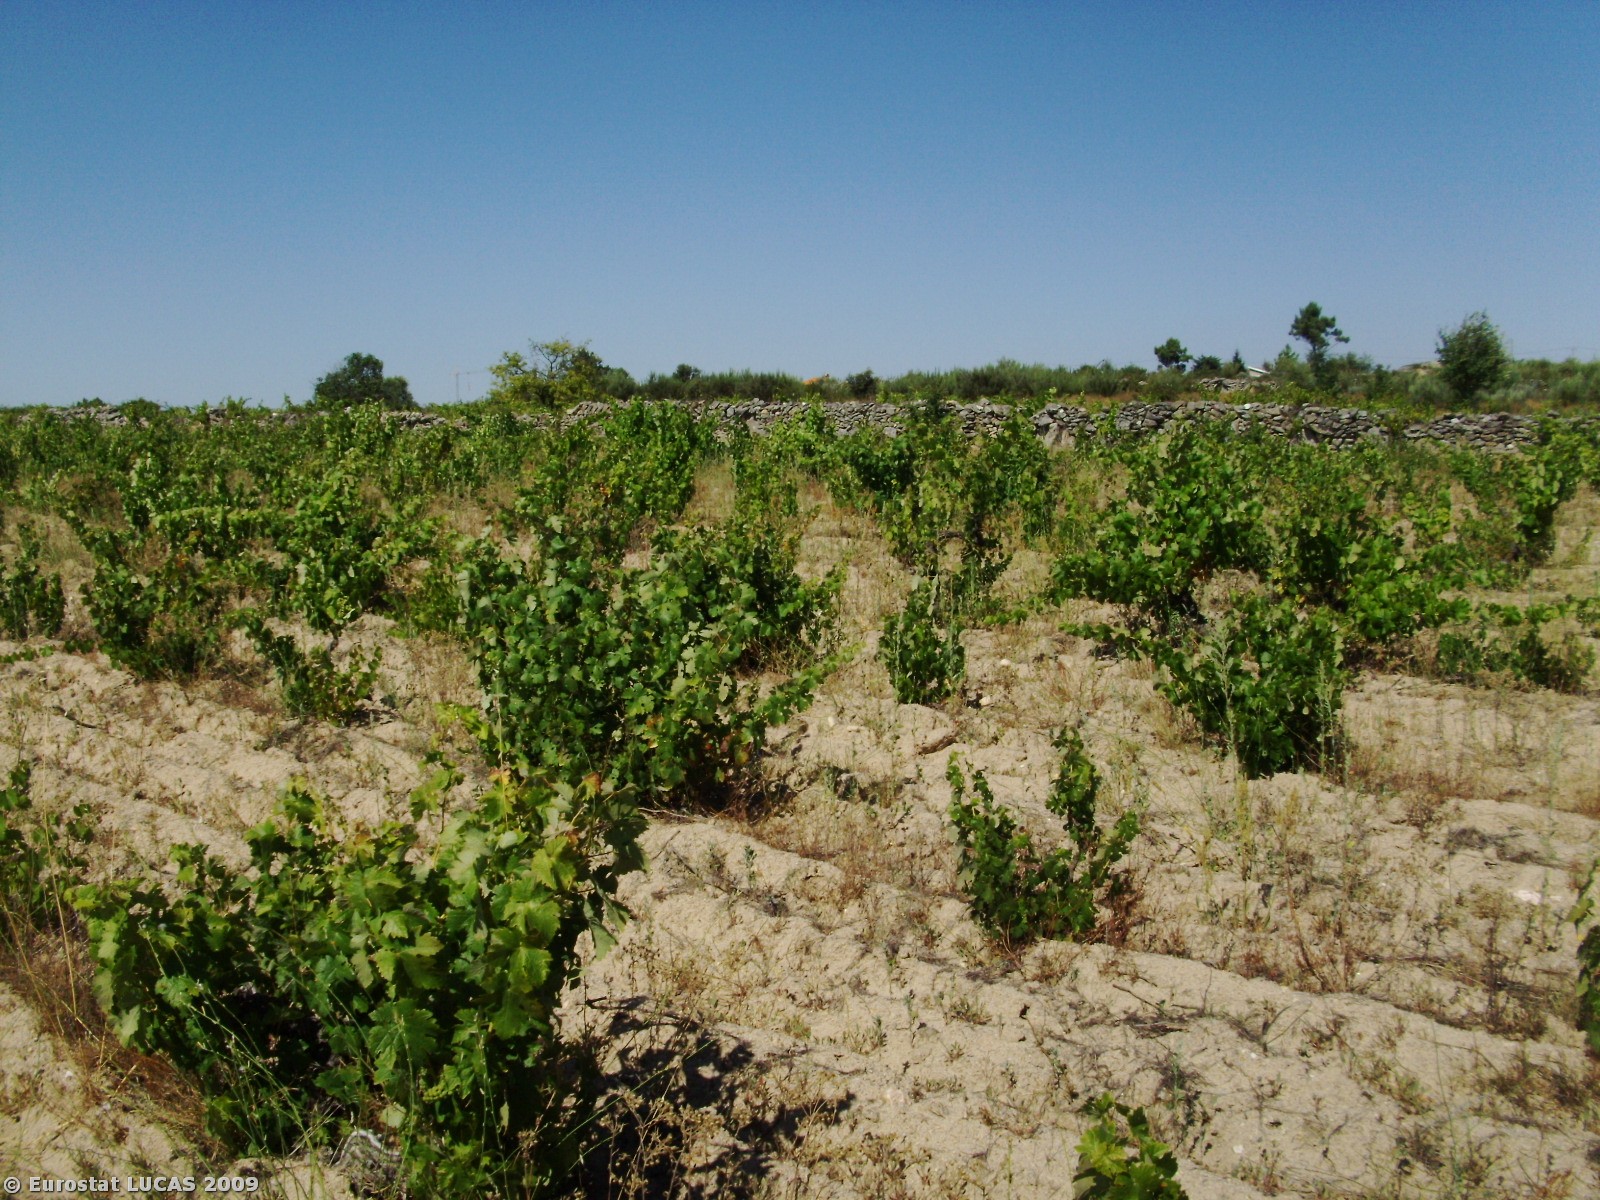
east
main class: Cropland
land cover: Vineyards
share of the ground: 50 - 75 %
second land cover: Bare land
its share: 25 - 50 %
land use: Agriculture (excluding fallow land and kitchen gardens)
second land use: Fallow land
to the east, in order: Vineyards; Bare land; Vineyards; Dry stone walls; Vineyards; Dry stone walls; Shrubland without tree cover; Dry stone walls; Bare land; Dry stone walls; Tracks; Dry stone walls; Spontaneously vegetated surfaces
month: July
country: PT
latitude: 40.5029
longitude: -7.0089
